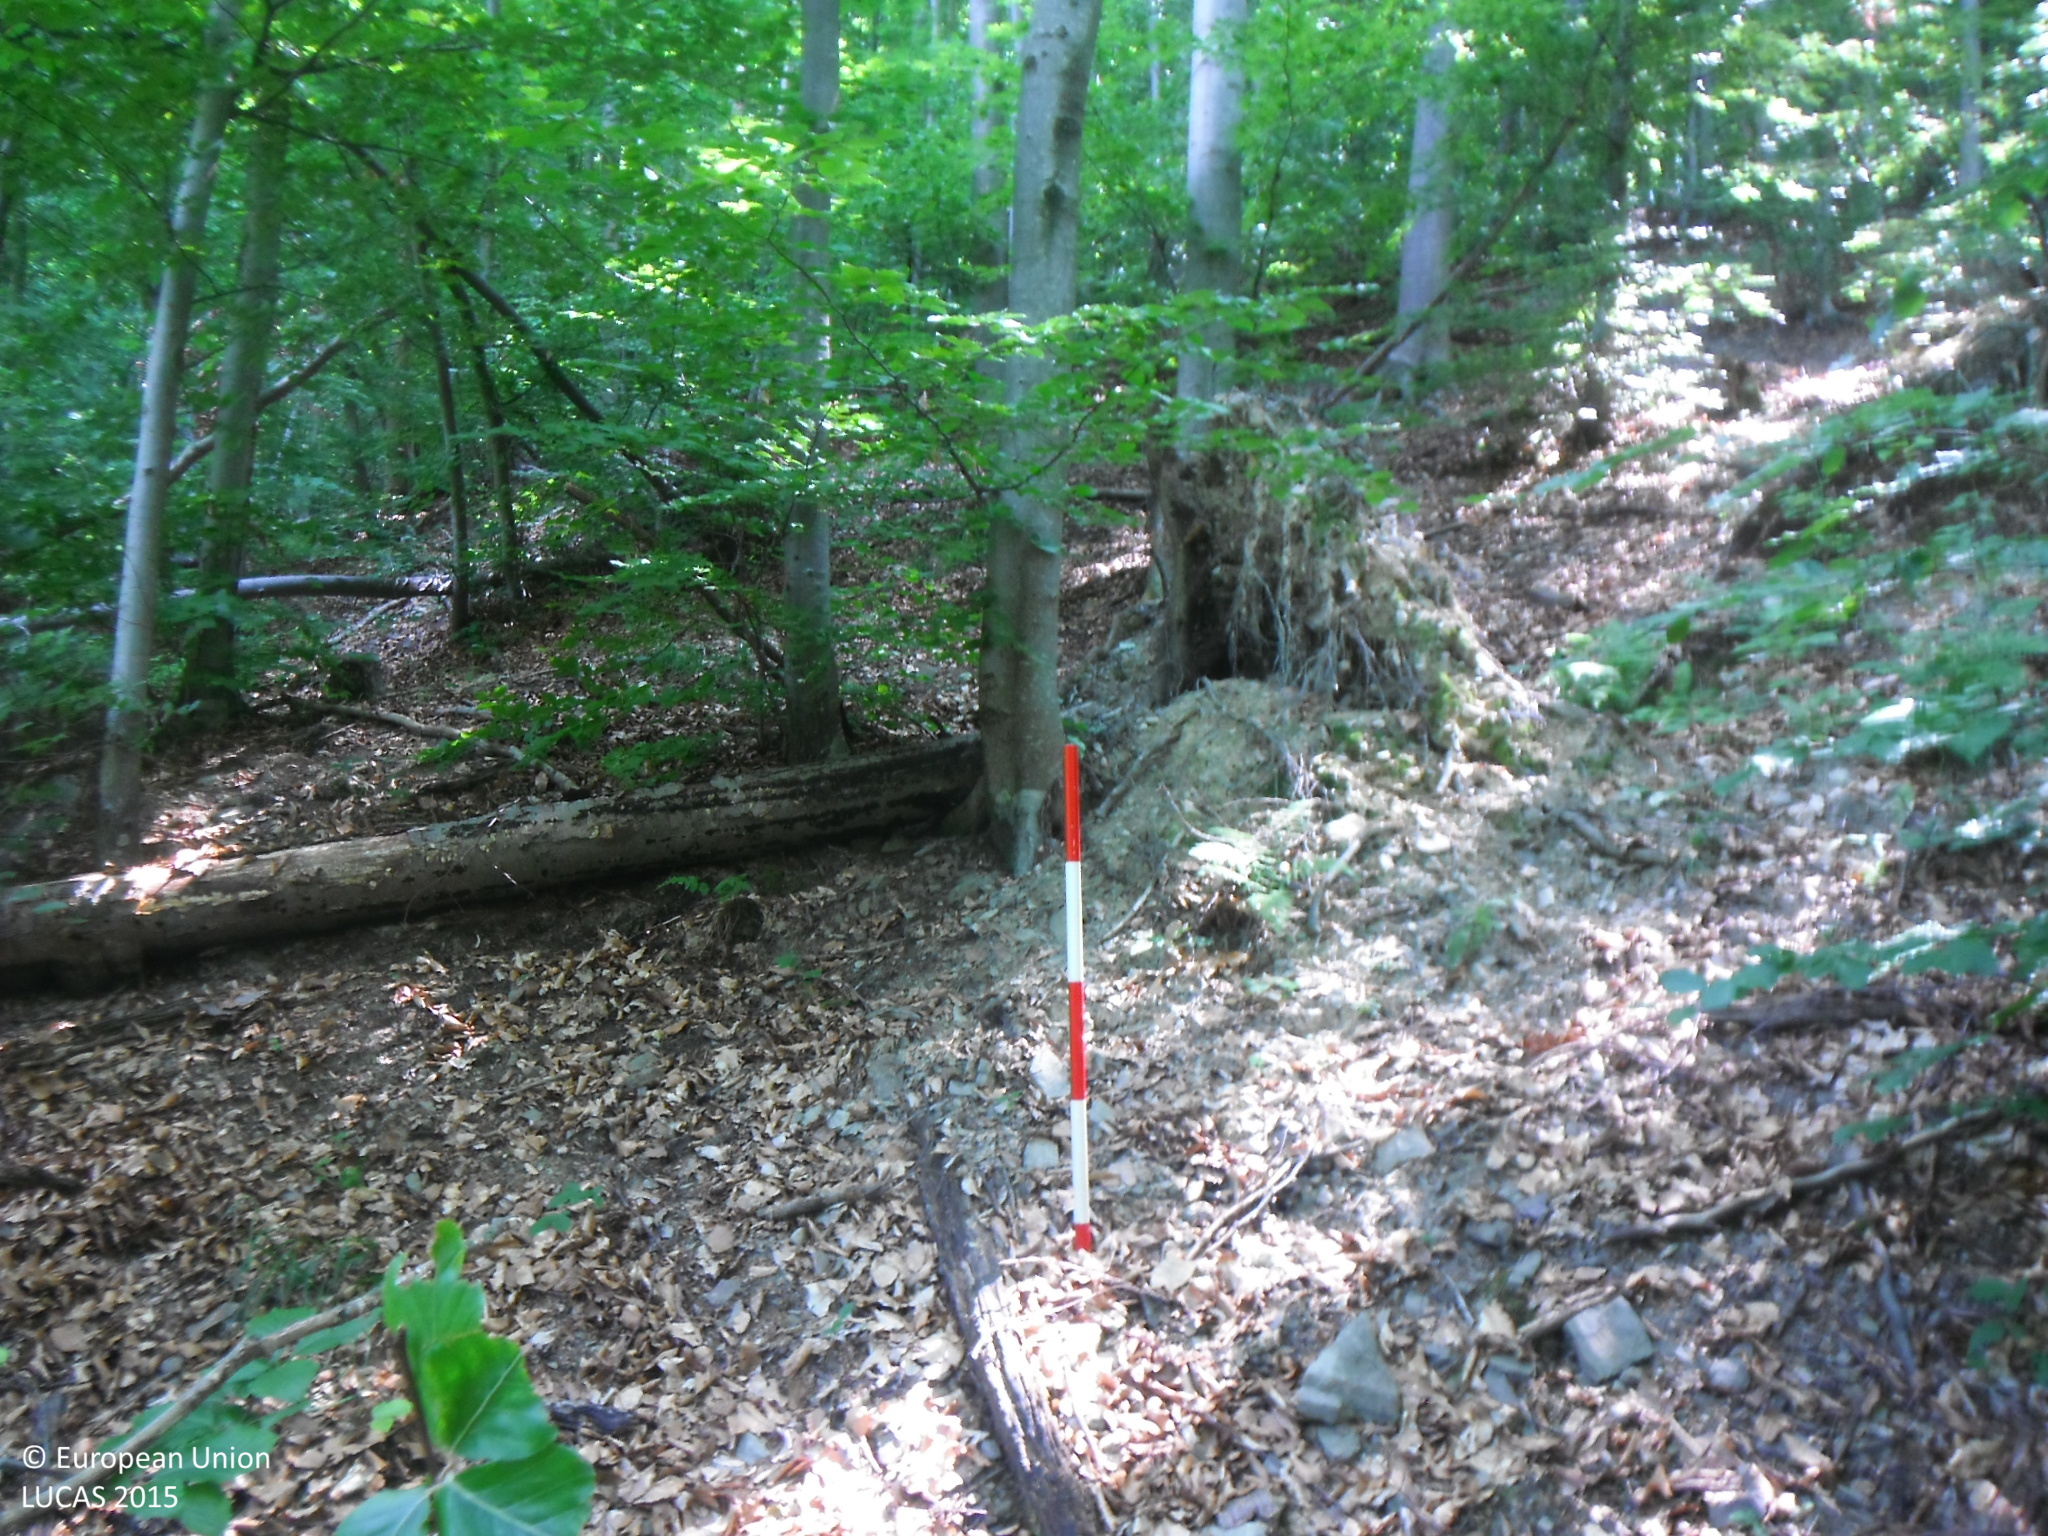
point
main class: Woodland
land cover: Broadleaved woodland
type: beech forest
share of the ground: > 75 %
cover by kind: broadleaved forest trees 100 %
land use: Forestry
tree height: > 5 m
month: July
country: SK
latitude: 48.9972
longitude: 22.3762
